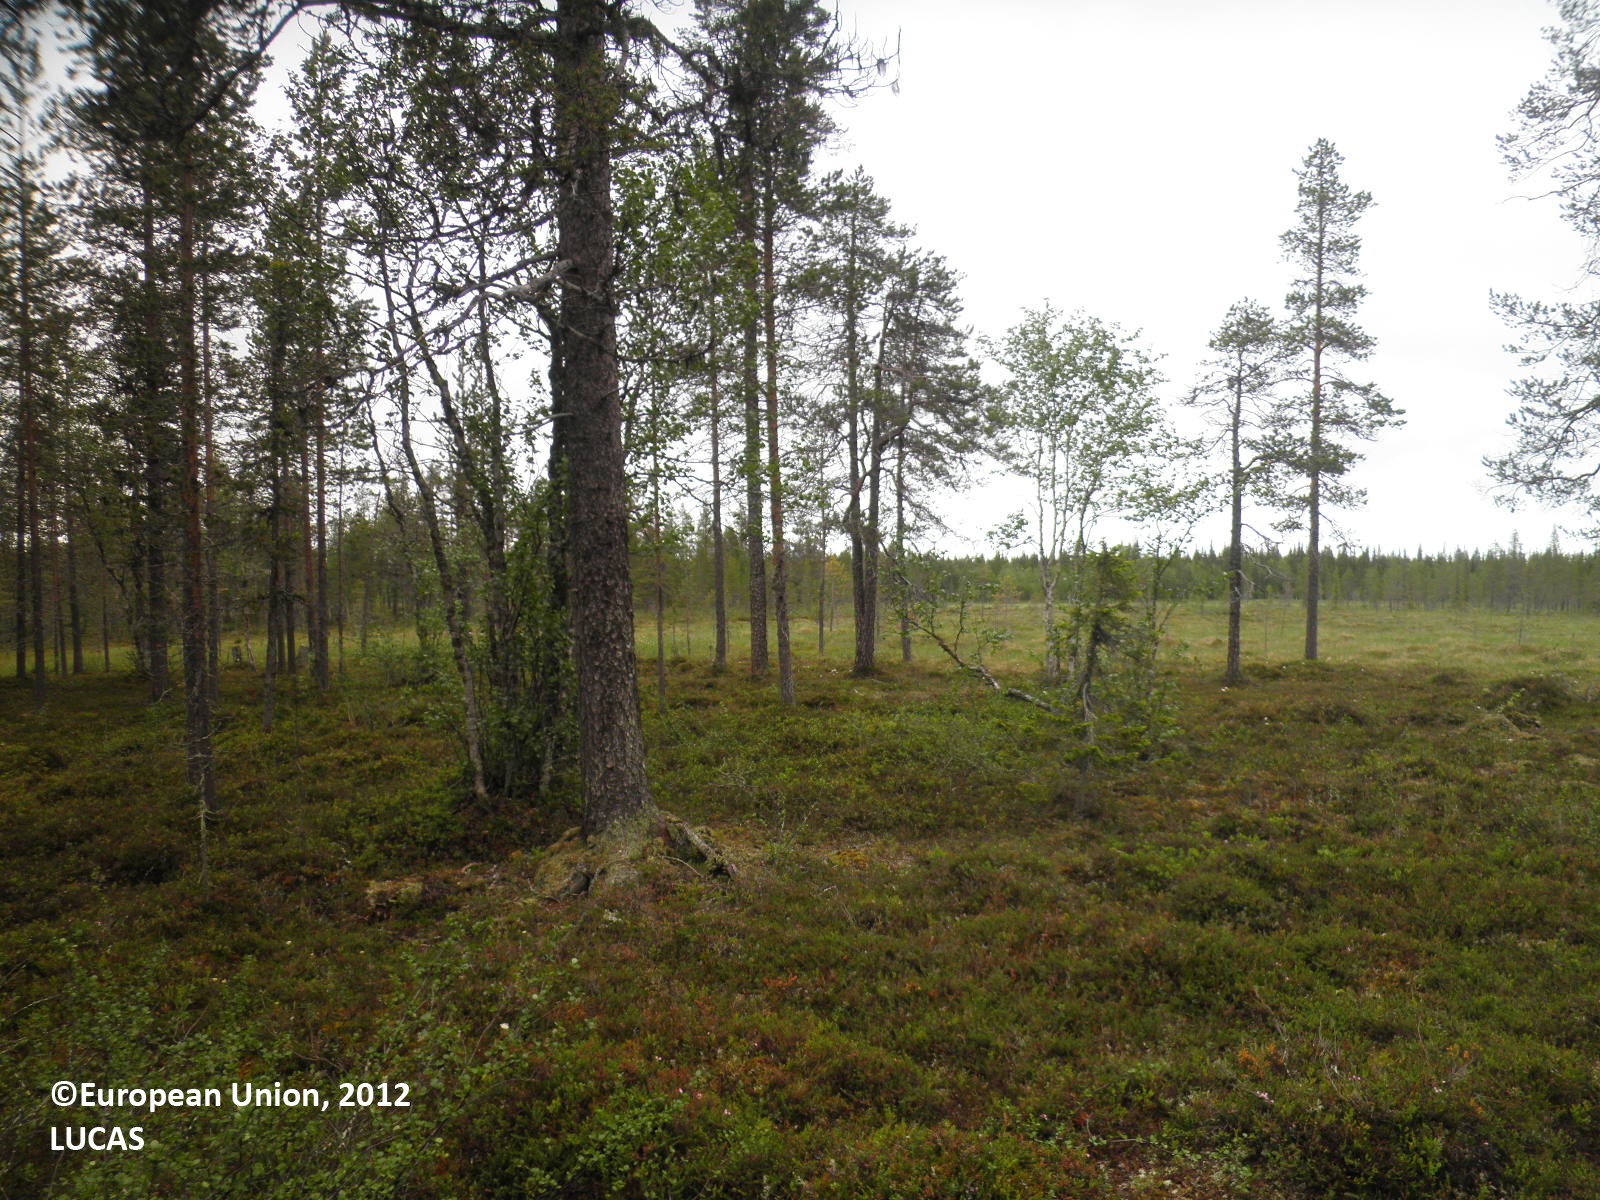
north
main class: Woodland
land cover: Pine dominated coniferous woodland
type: boreal forest
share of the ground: 50 - 75 %
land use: Forestry
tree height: > 5 m
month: July
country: FI
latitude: 68.2123
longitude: 25.6610
